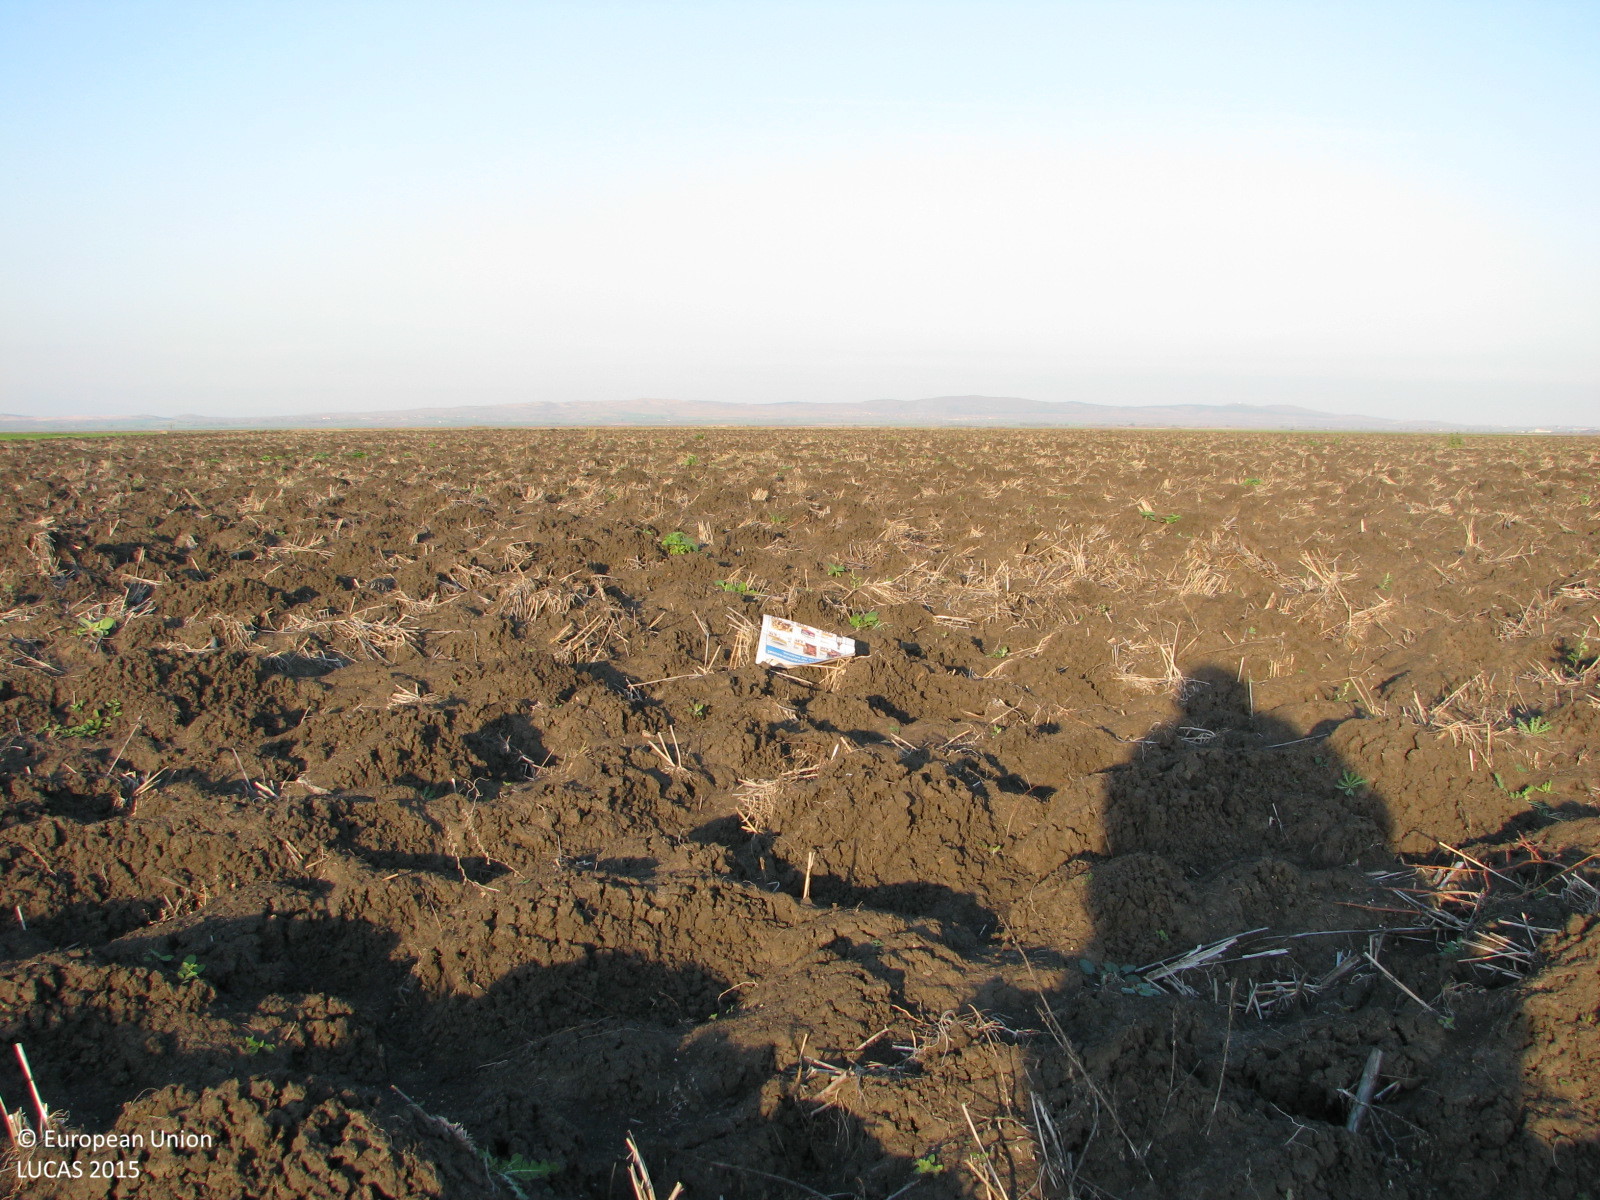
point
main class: Cropland
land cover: Common wheat
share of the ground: < 10 %
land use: Agriculture (excluding fallow land and kitchen gardens)
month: November
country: BG
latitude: 42.3436
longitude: 26.0168
